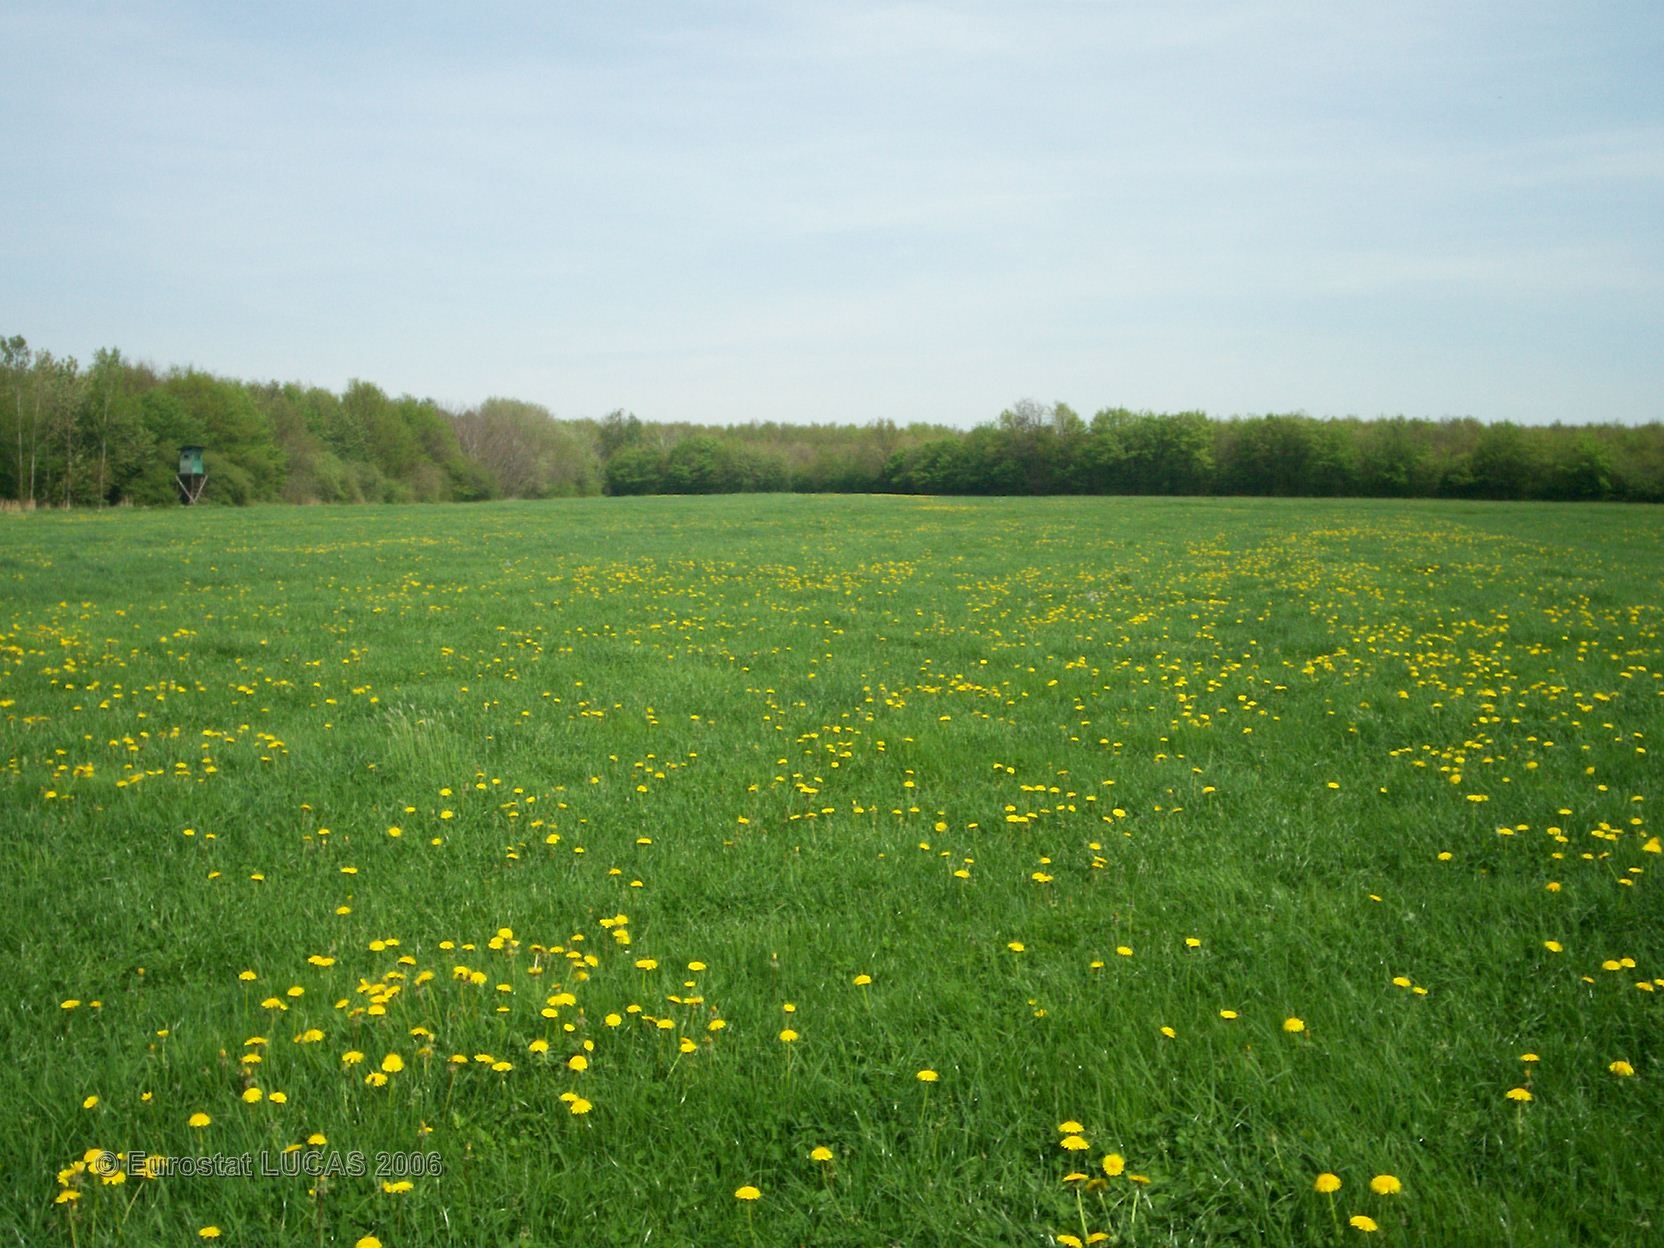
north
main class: Grassland
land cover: Grassland without tree/shrub cover
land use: Agriculture (excluding fallow land and kitchen gardens)
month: May
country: FR
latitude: 48.9407
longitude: 7.0652
